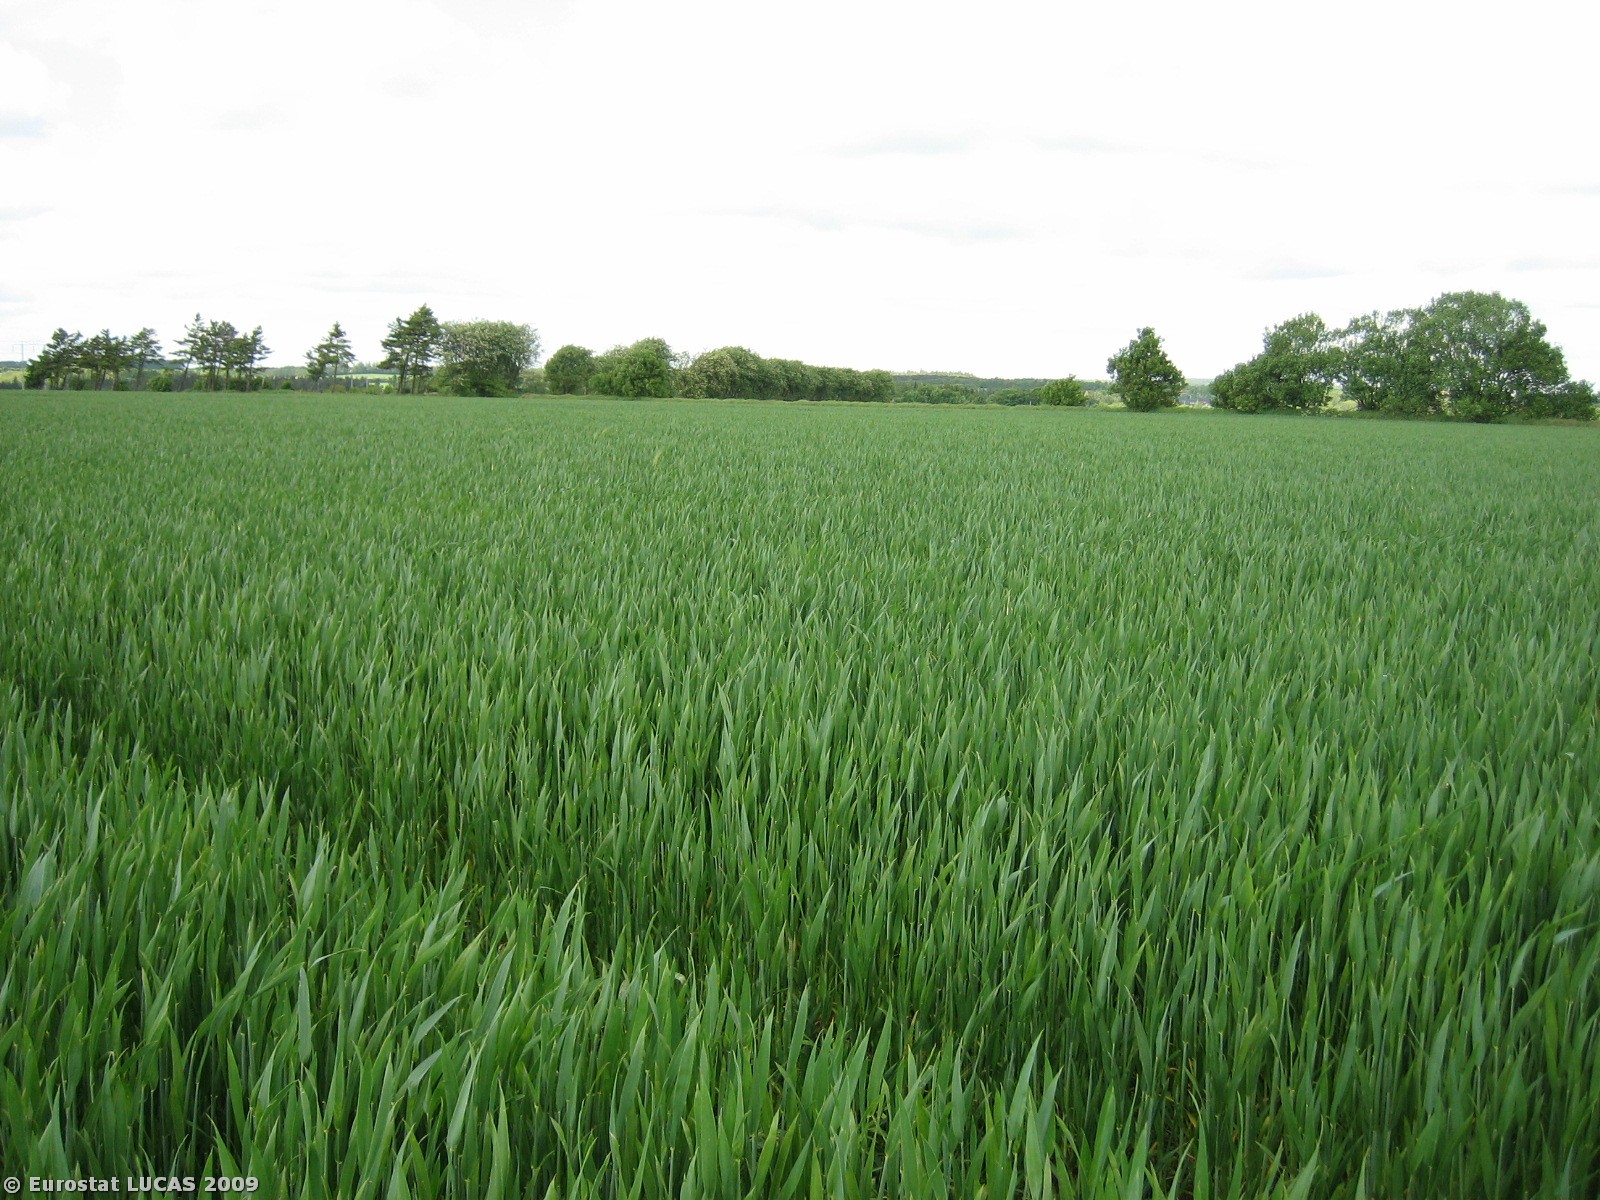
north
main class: Cropland
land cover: Barley
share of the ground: > 75 %
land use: Agriculture (excluding fallow land and kitchen gardens)
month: May
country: DK
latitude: 56.0206
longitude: 8.8301
